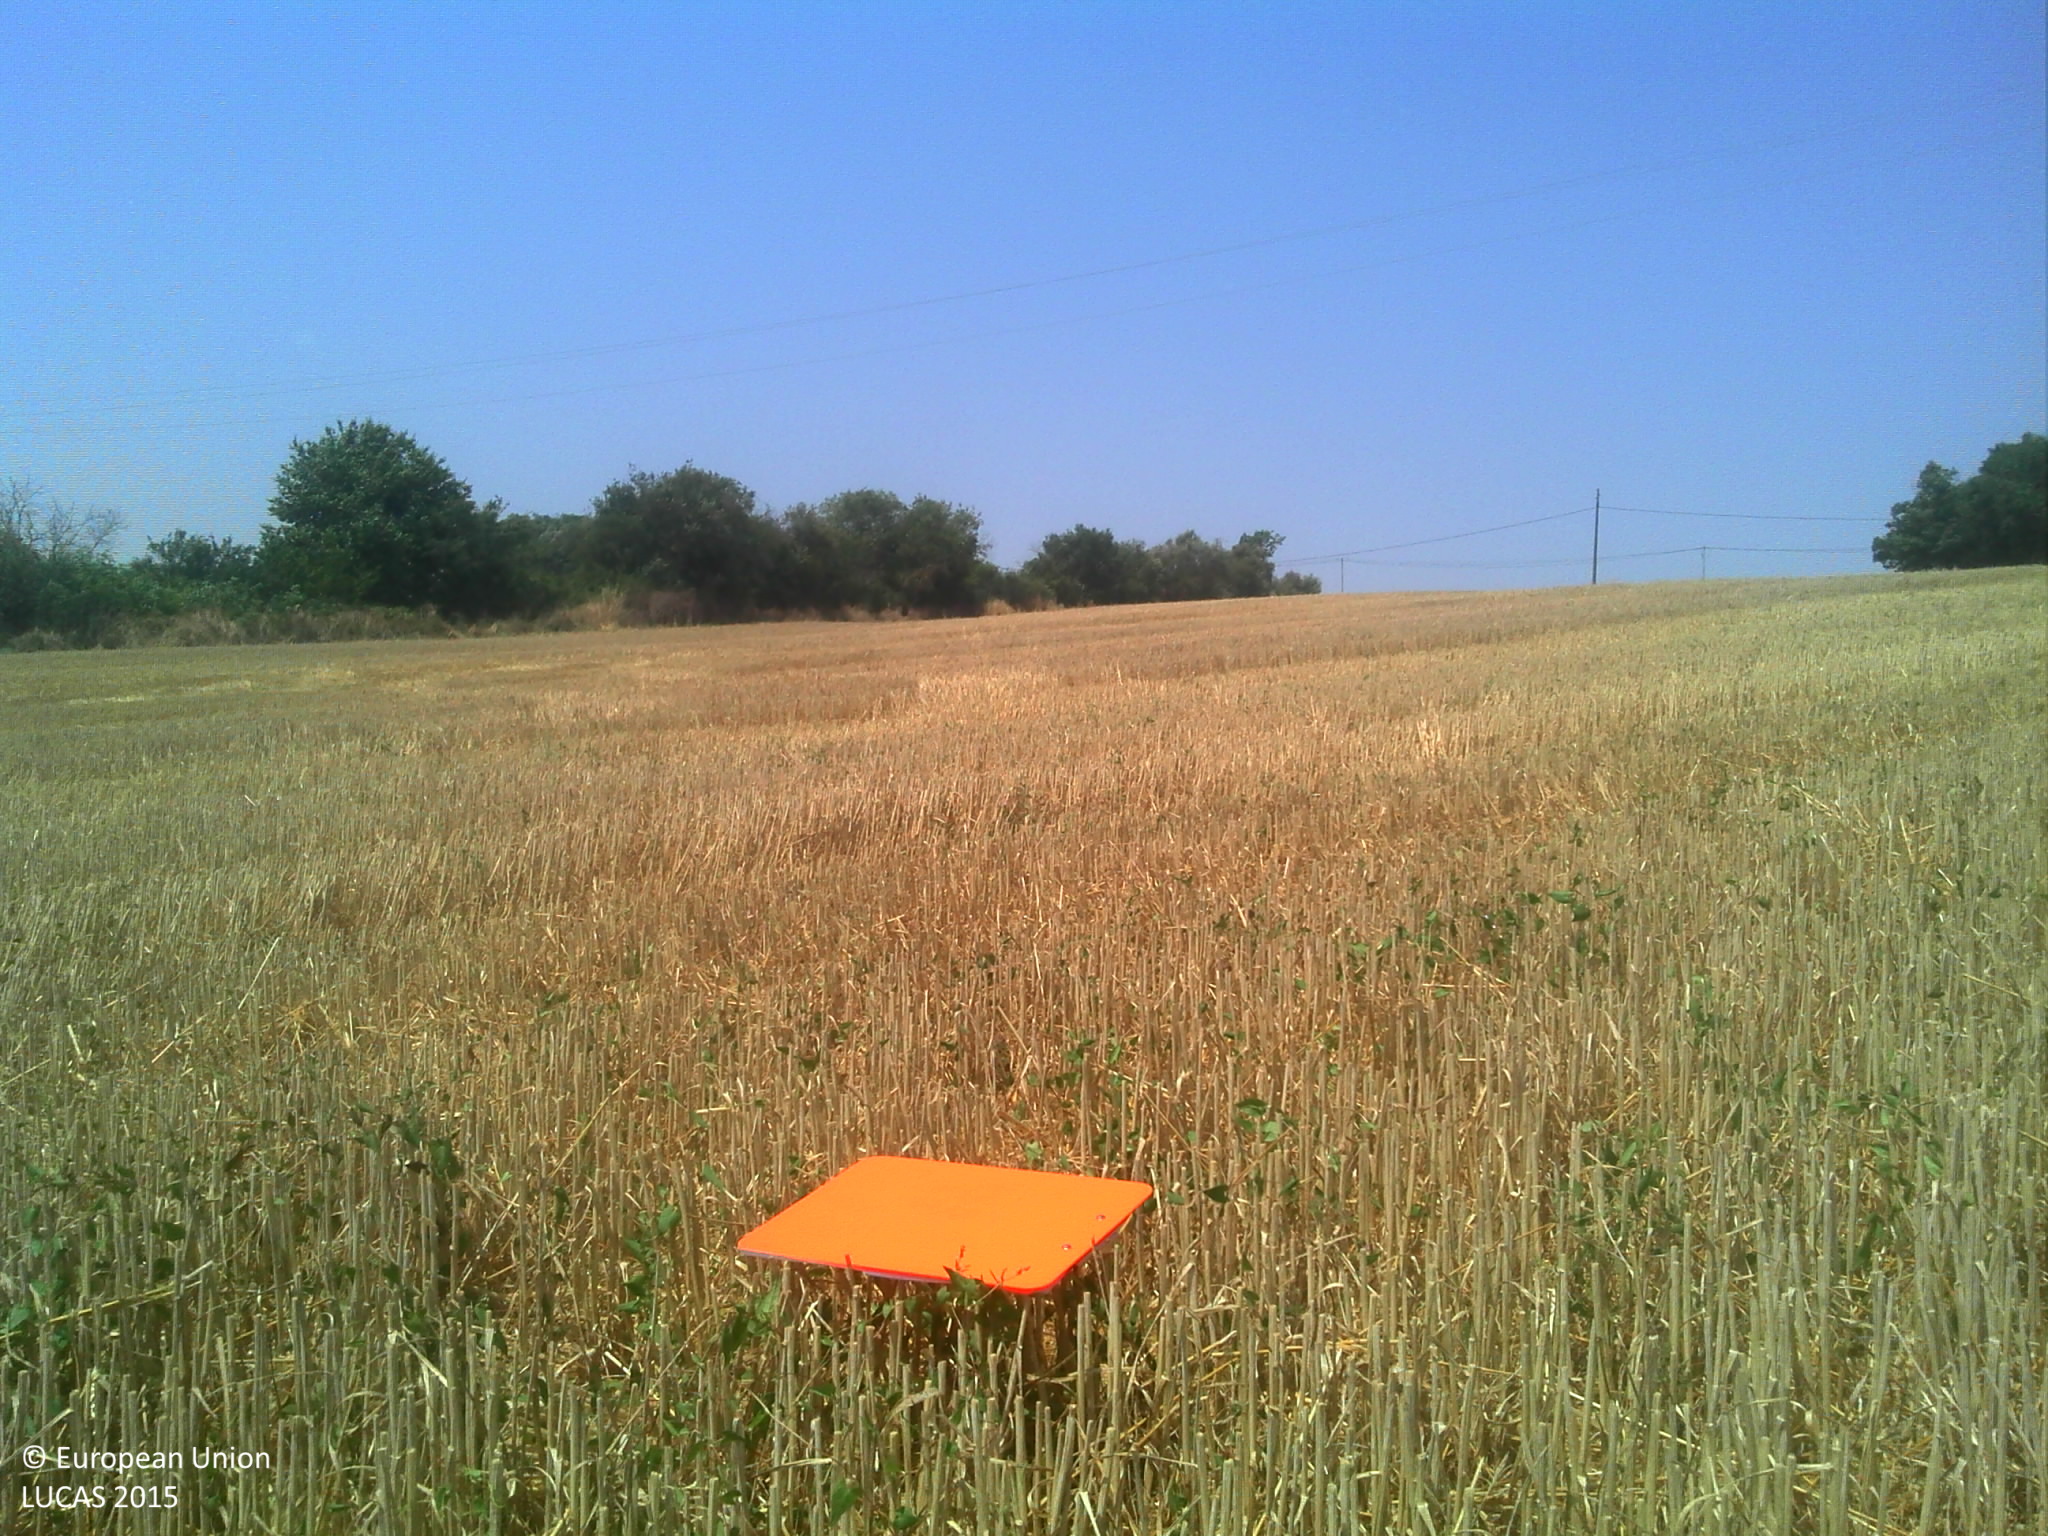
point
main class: Cropland
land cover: Common wheat
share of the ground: > 75 %
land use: Agriculture (excluding fallow land and kitchen gardens)
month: July
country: FR
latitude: 43.3671
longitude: 1.0800
